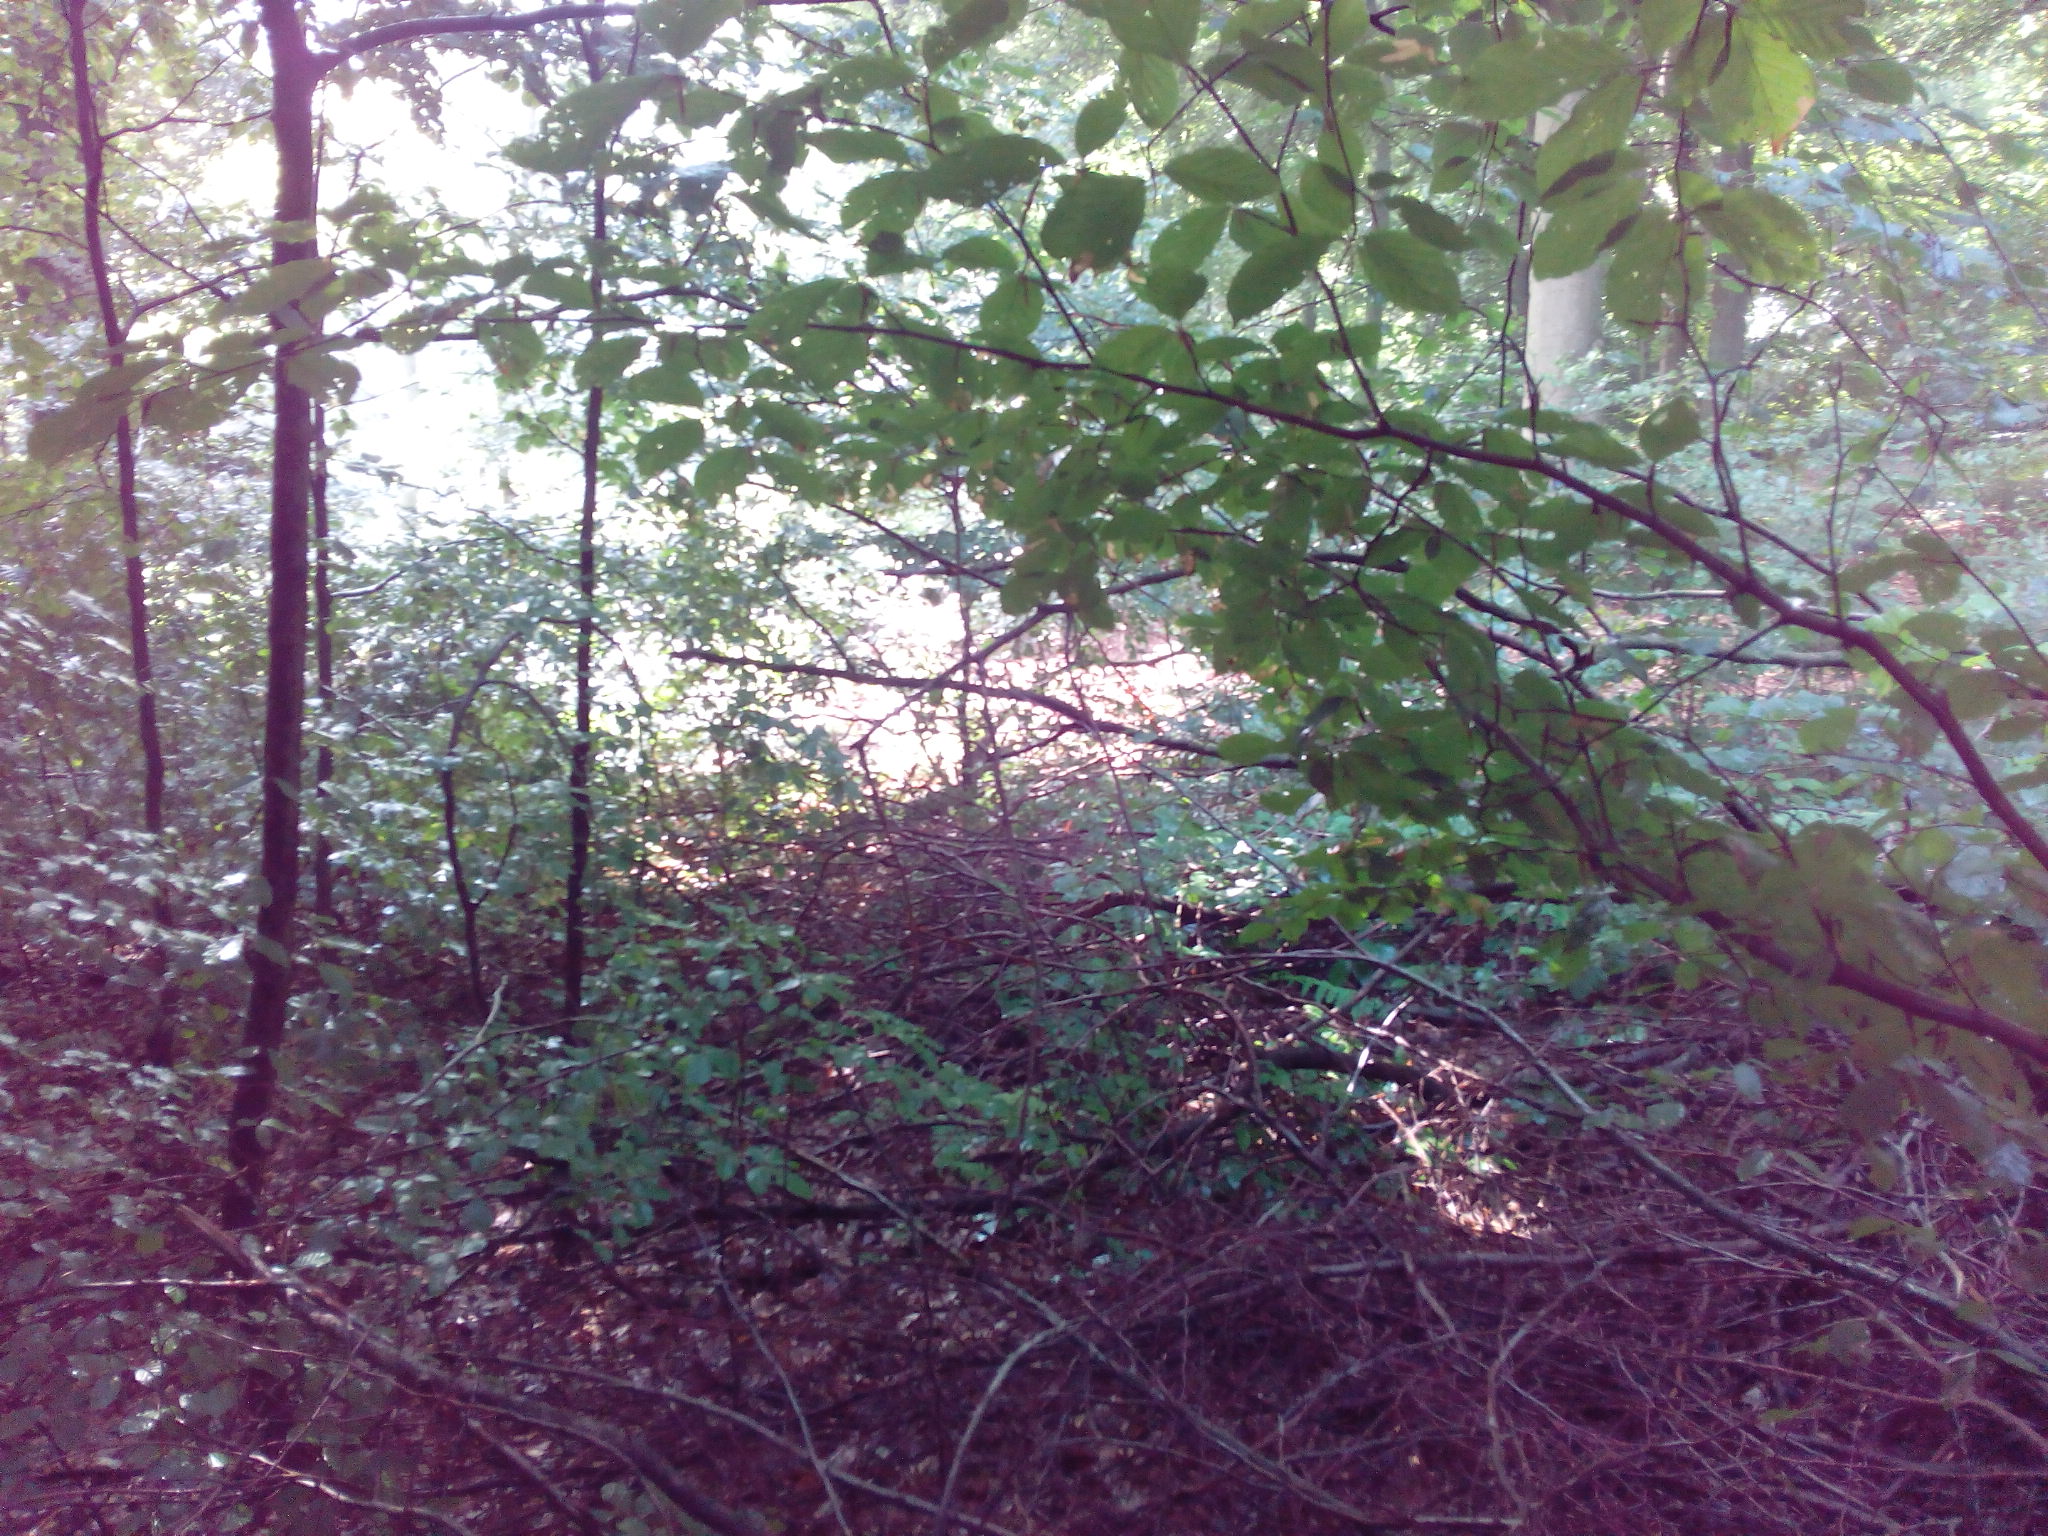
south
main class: Woodland
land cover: Broadleaved woodland
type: mesophytic deciduous forest
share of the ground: > 75 %
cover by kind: broadleaved forest trees 90 %, herbaceous plants 10 %
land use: Forestry
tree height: > 5 m
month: August
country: DE
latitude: 52.1078
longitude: 9.8978
